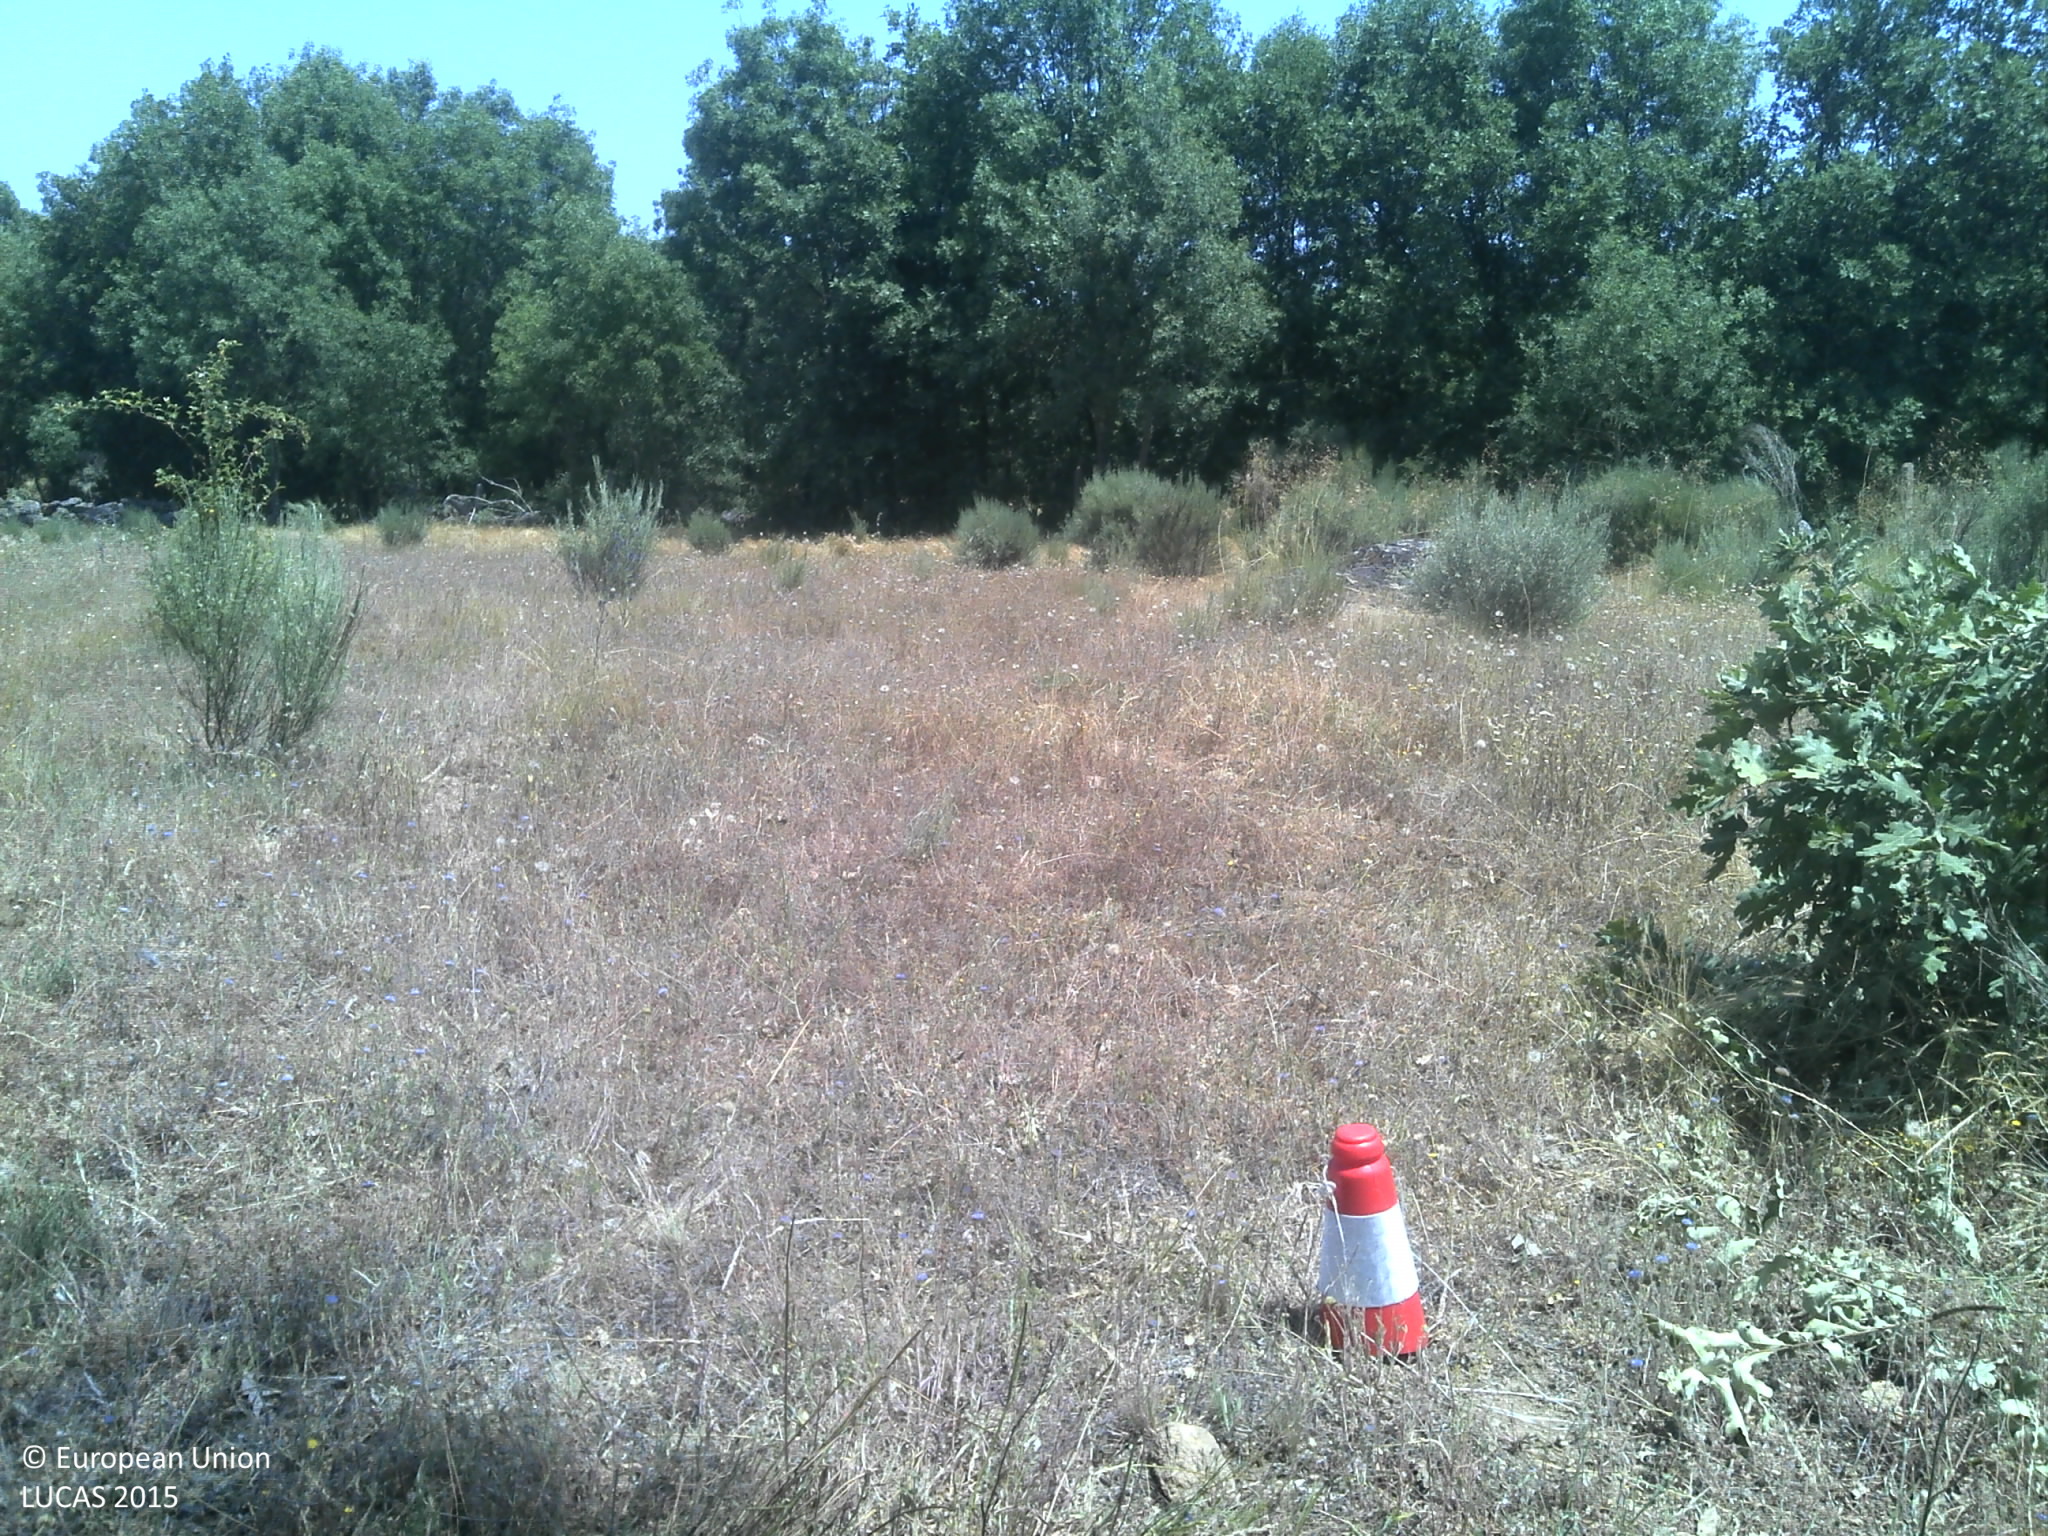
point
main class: Grassland
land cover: Grassland with sparse tree/shrub cover
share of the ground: 50 - 75 %
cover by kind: herbaceous plants 75 %, unconsolidated bare surface 20 %, broadleaved forest trees 5 %
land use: Agriculture (excluding fallow land and kitchen gardens)
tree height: > 5 m
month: June
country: PT
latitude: 40.3726
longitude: -6.8046
